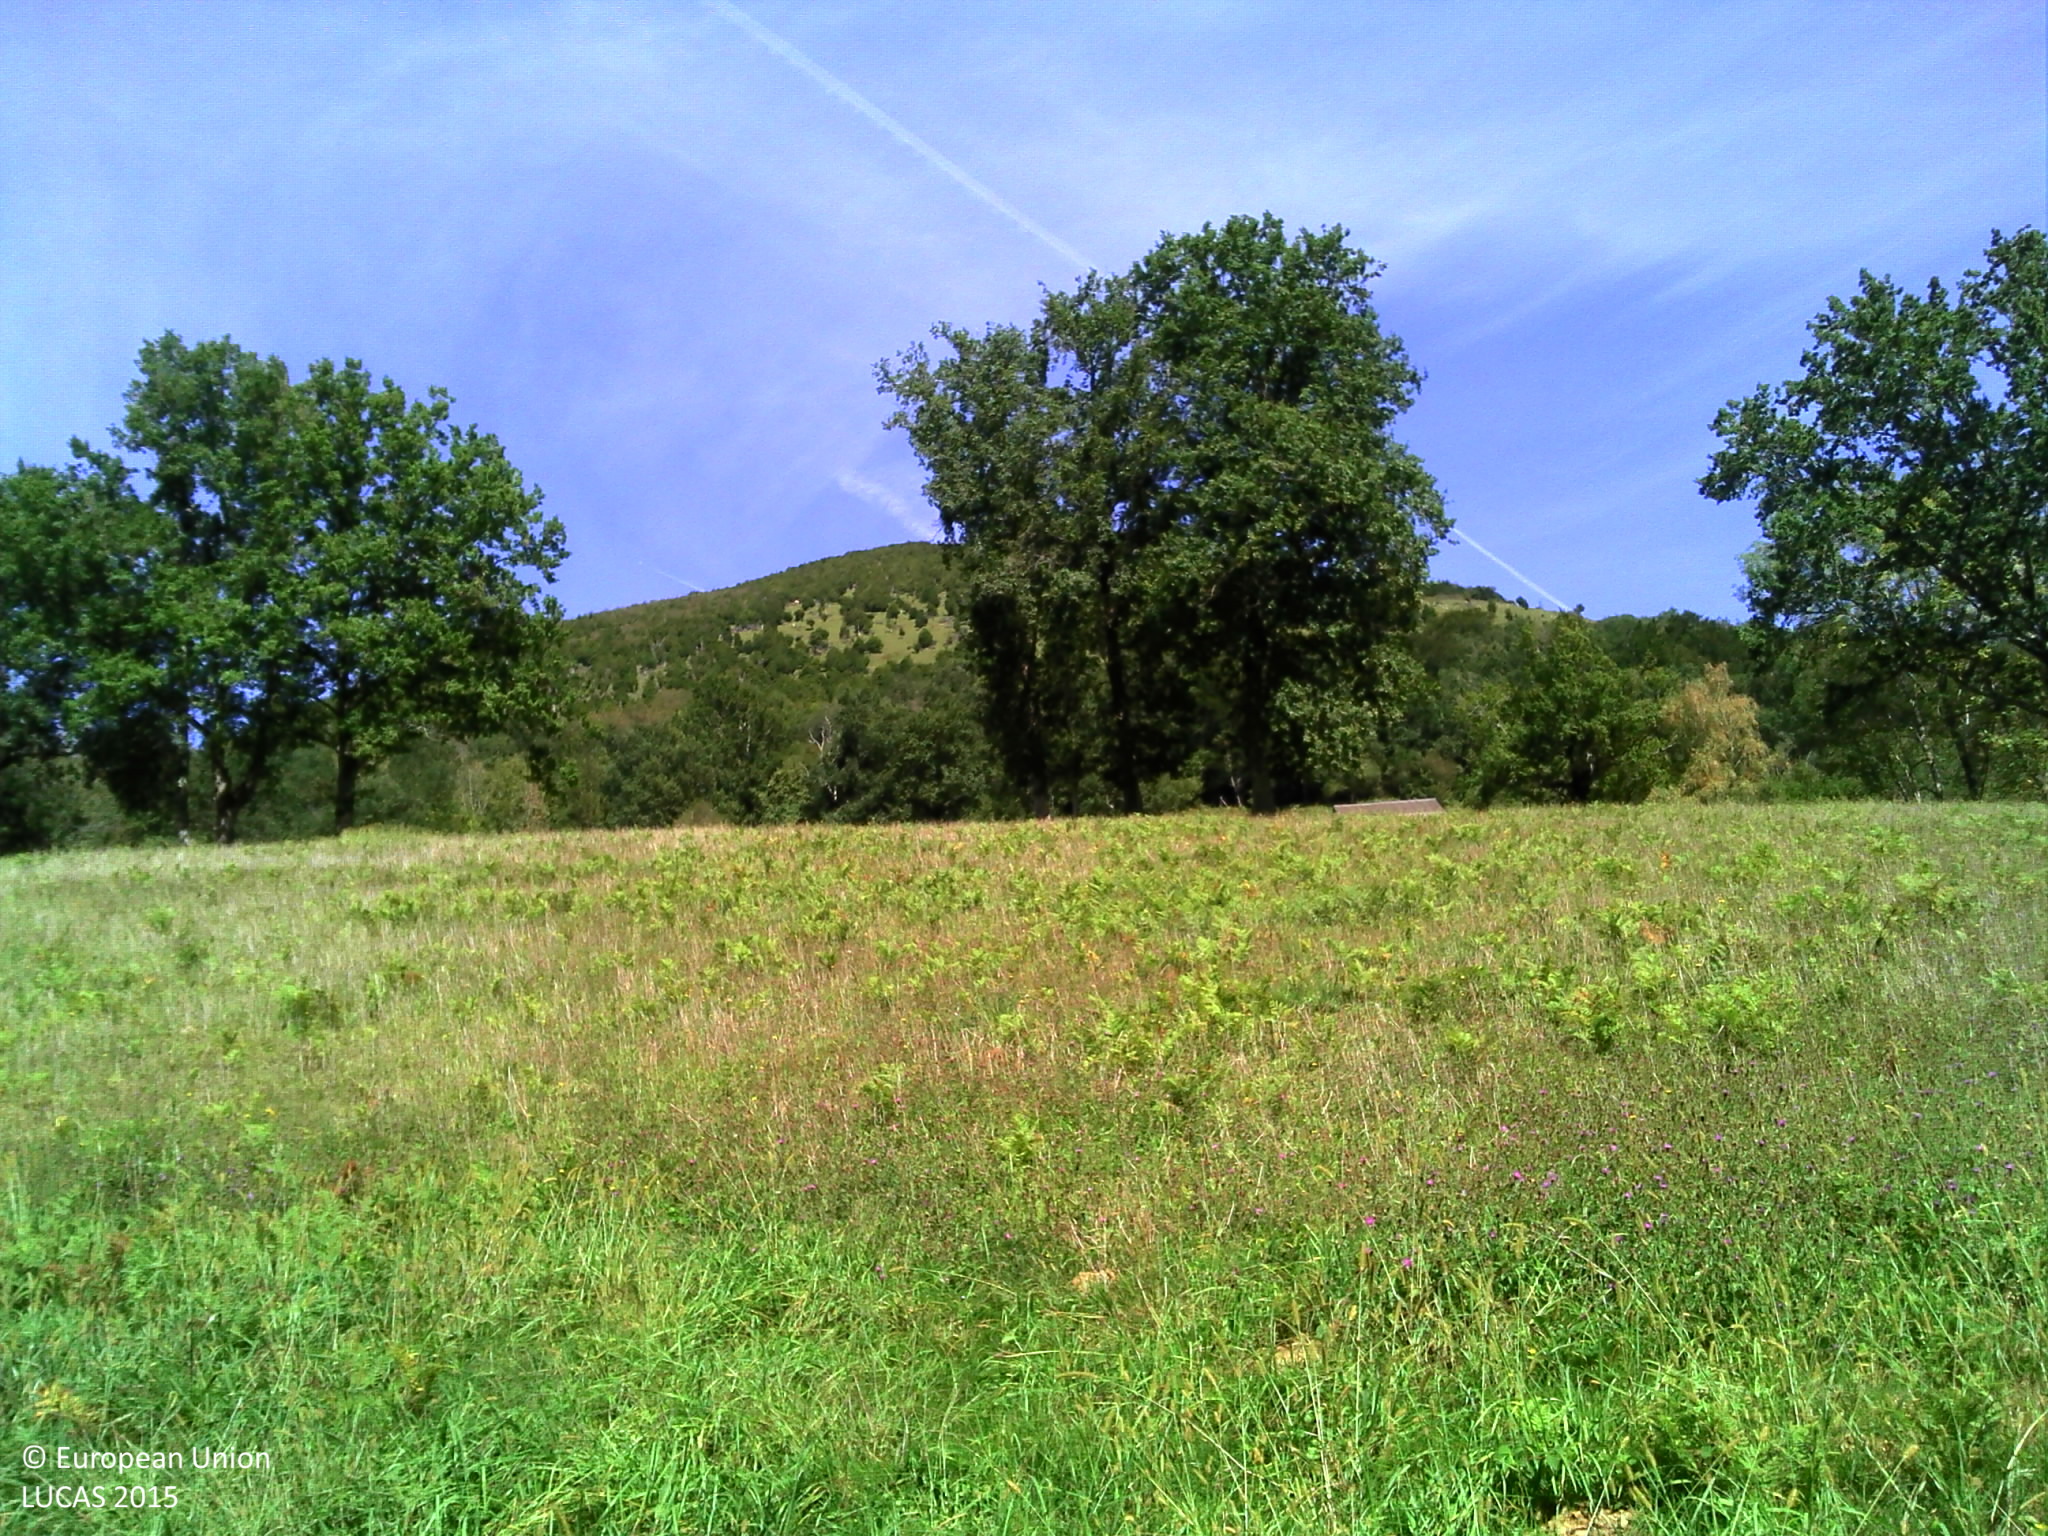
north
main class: Grassland
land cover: Grassland without tree/shrub cover
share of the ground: > 75 %
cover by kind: herbaceous plants 95 %, shrubs 5 %
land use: Agriculture (excluding fallow land and kitchen gardens)
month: September
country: FR
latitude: 43.0934
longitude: -0.6342
